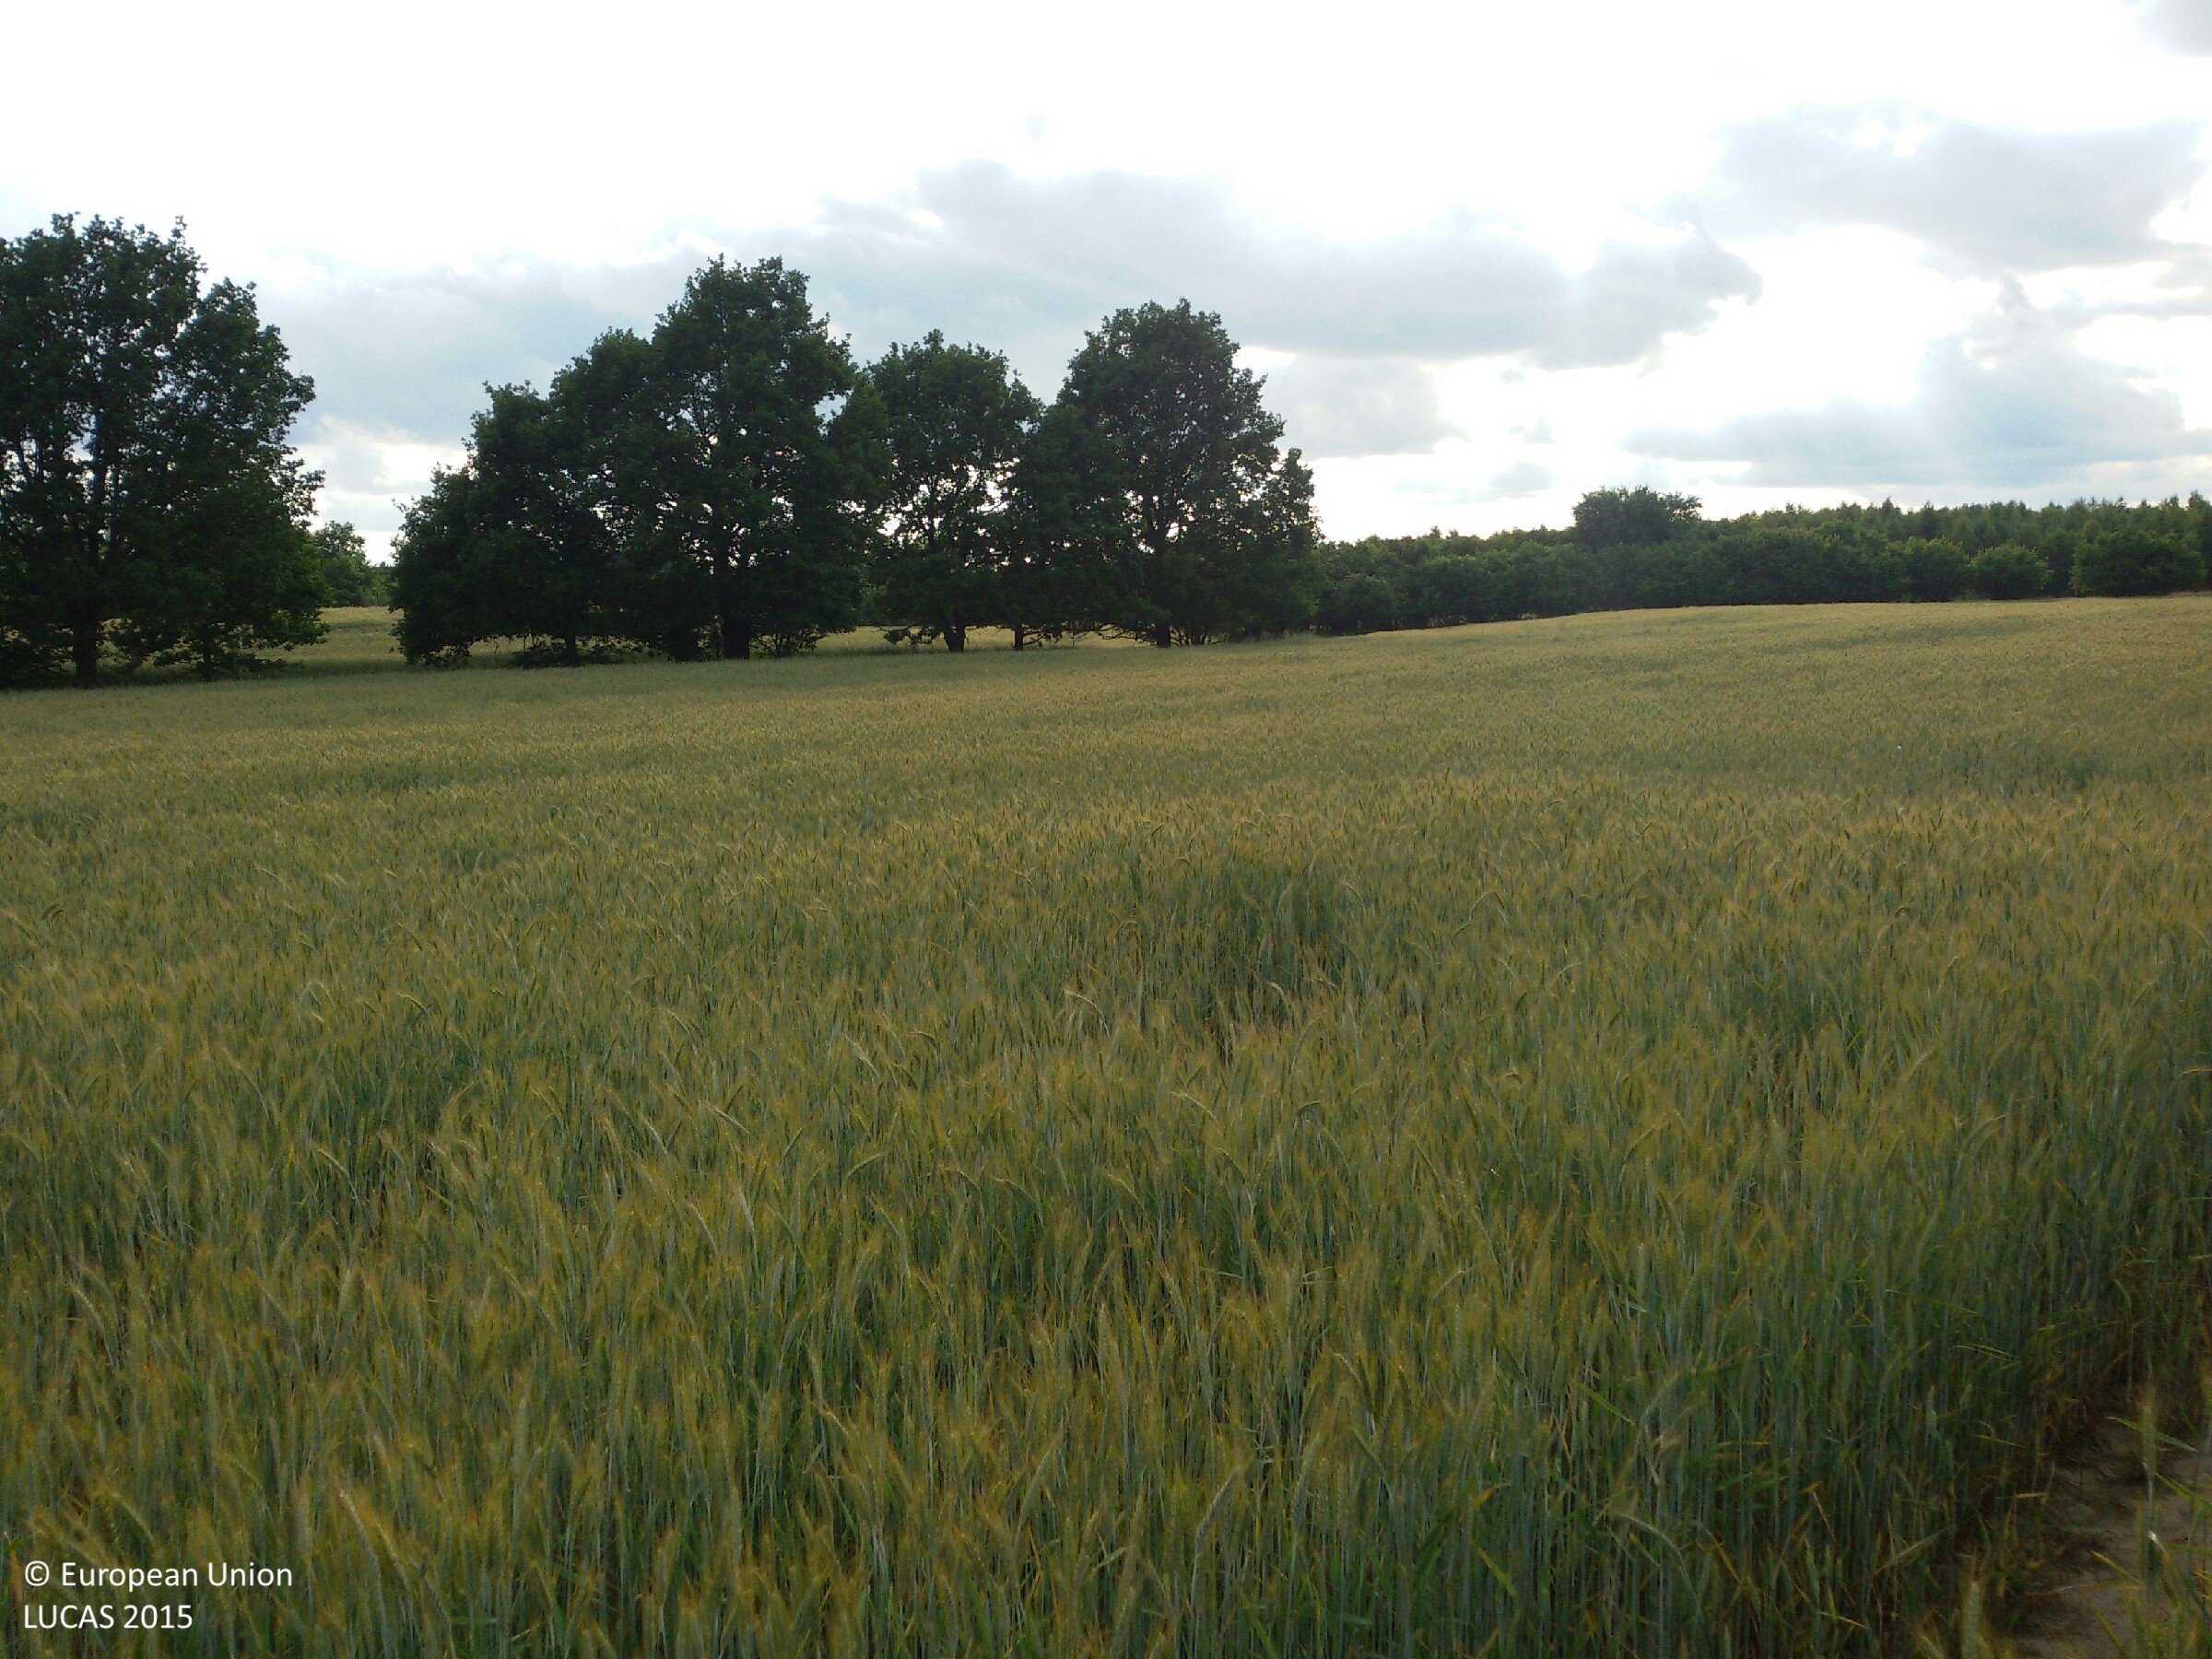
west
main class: Cropland
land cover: Common wheat
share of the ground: > 75 %
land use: Agriculture (excluding fallow land and kitchen gardens)
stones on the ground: < 10 %
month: June
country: PL
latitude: 53.4468
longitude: 20.1362
